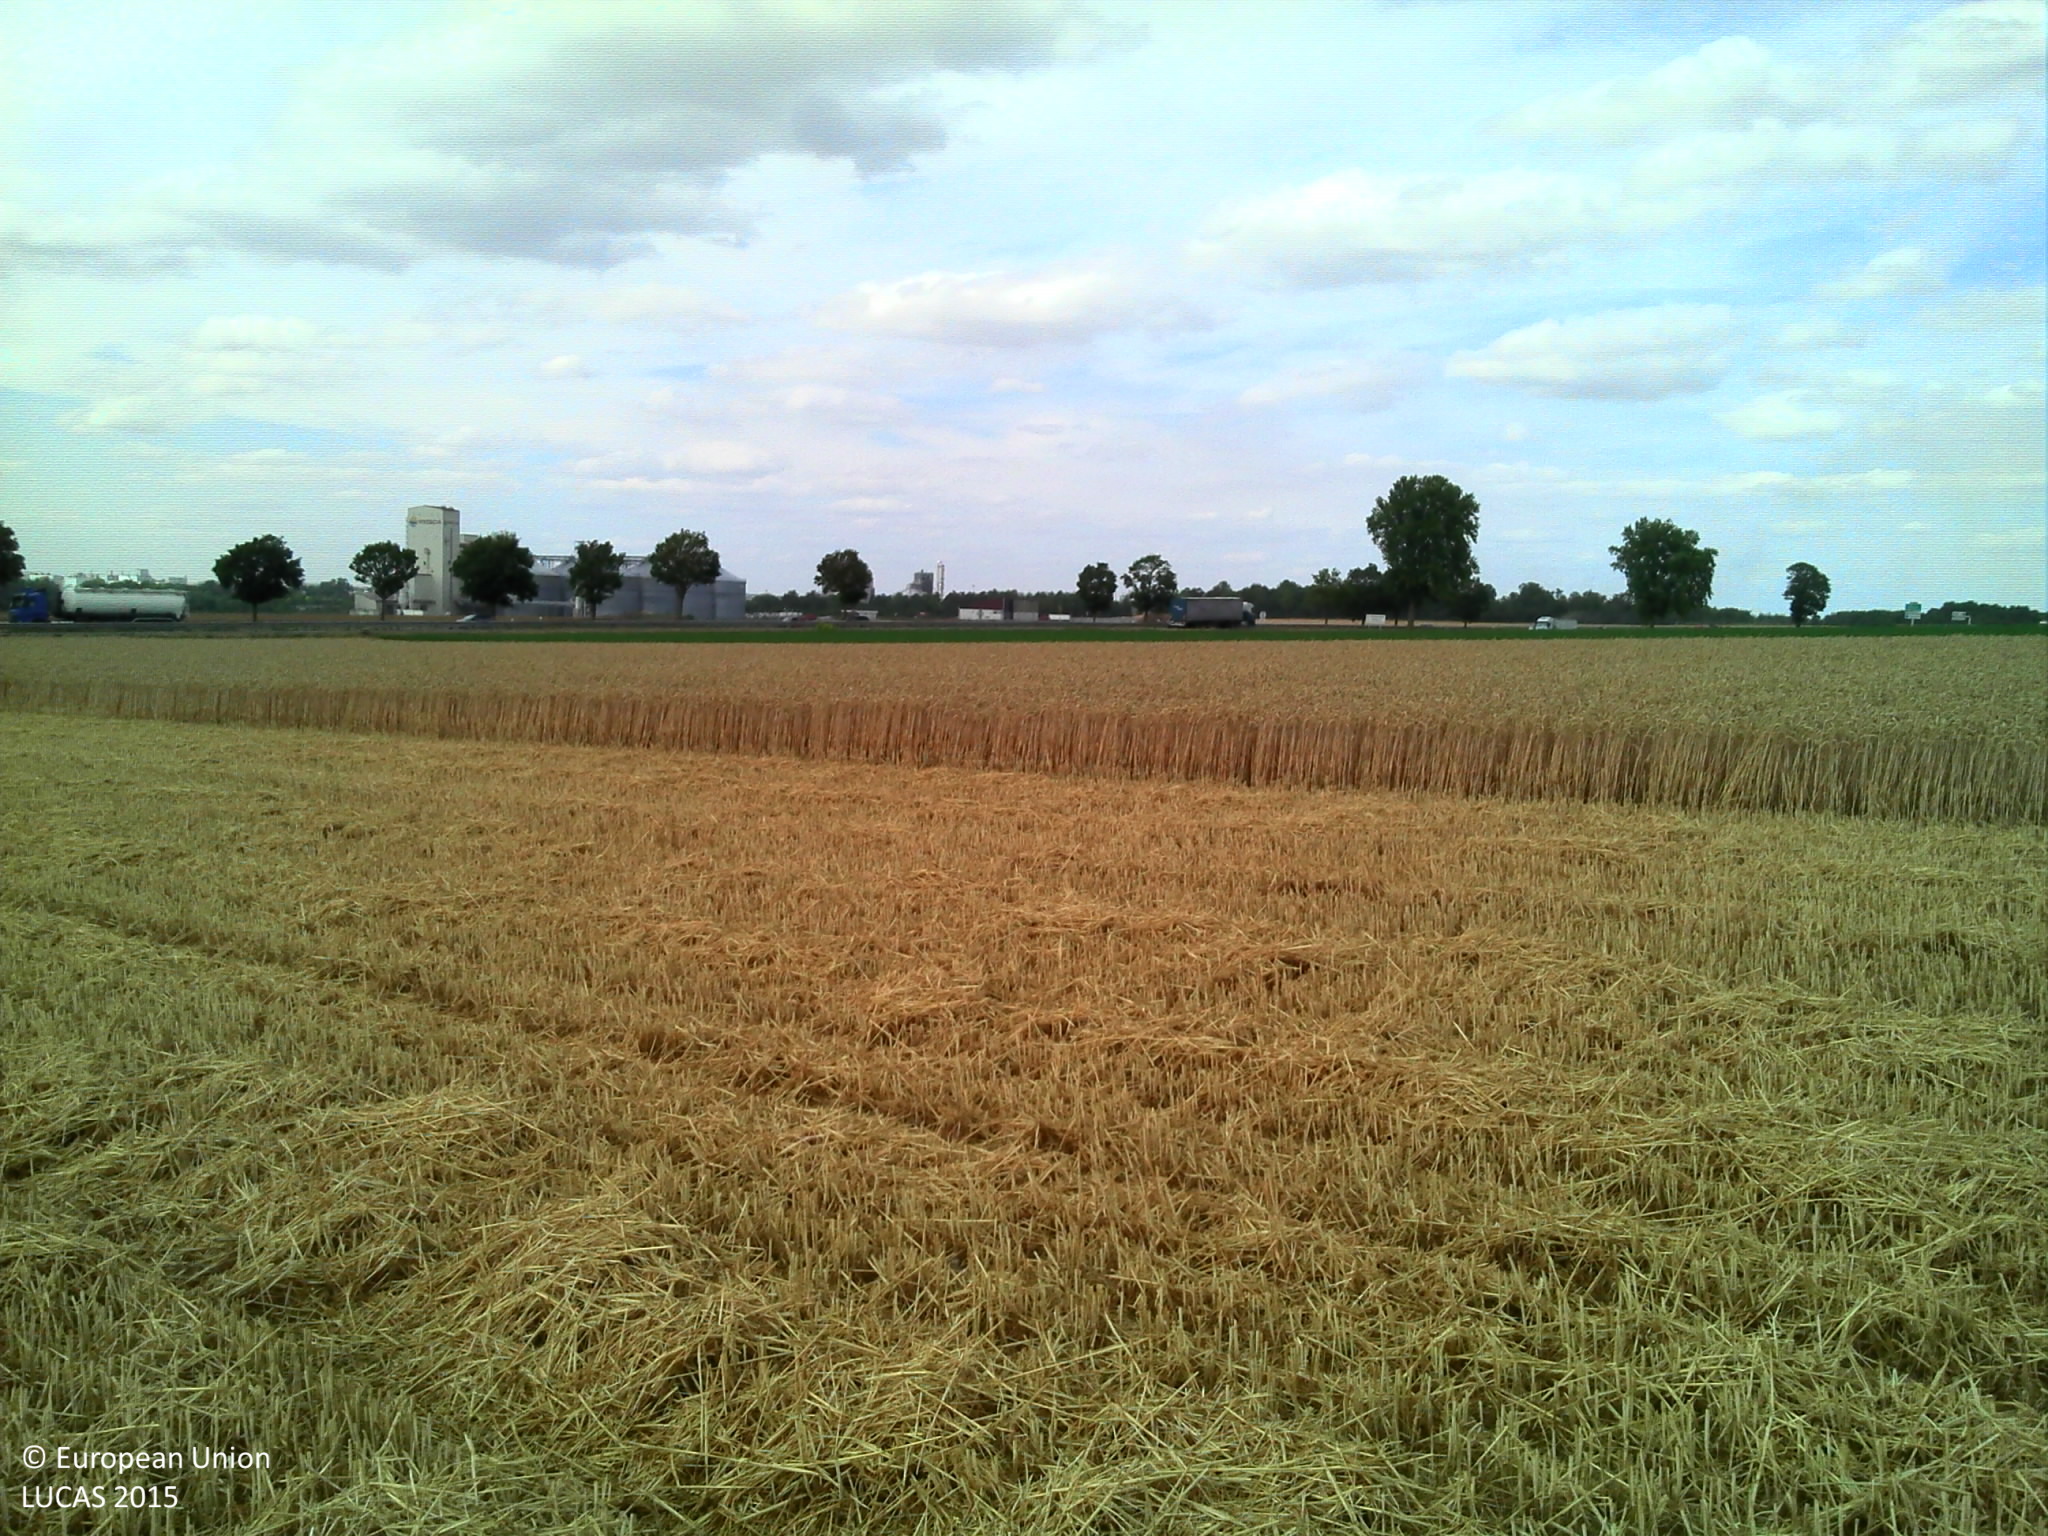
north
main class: Cropland
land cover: Common wheat
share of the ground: > 75 %
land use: Agriculture (excluding fallow land and kitchen gardens)
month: July
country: FR
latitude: 49.3321
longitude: 4.1746
